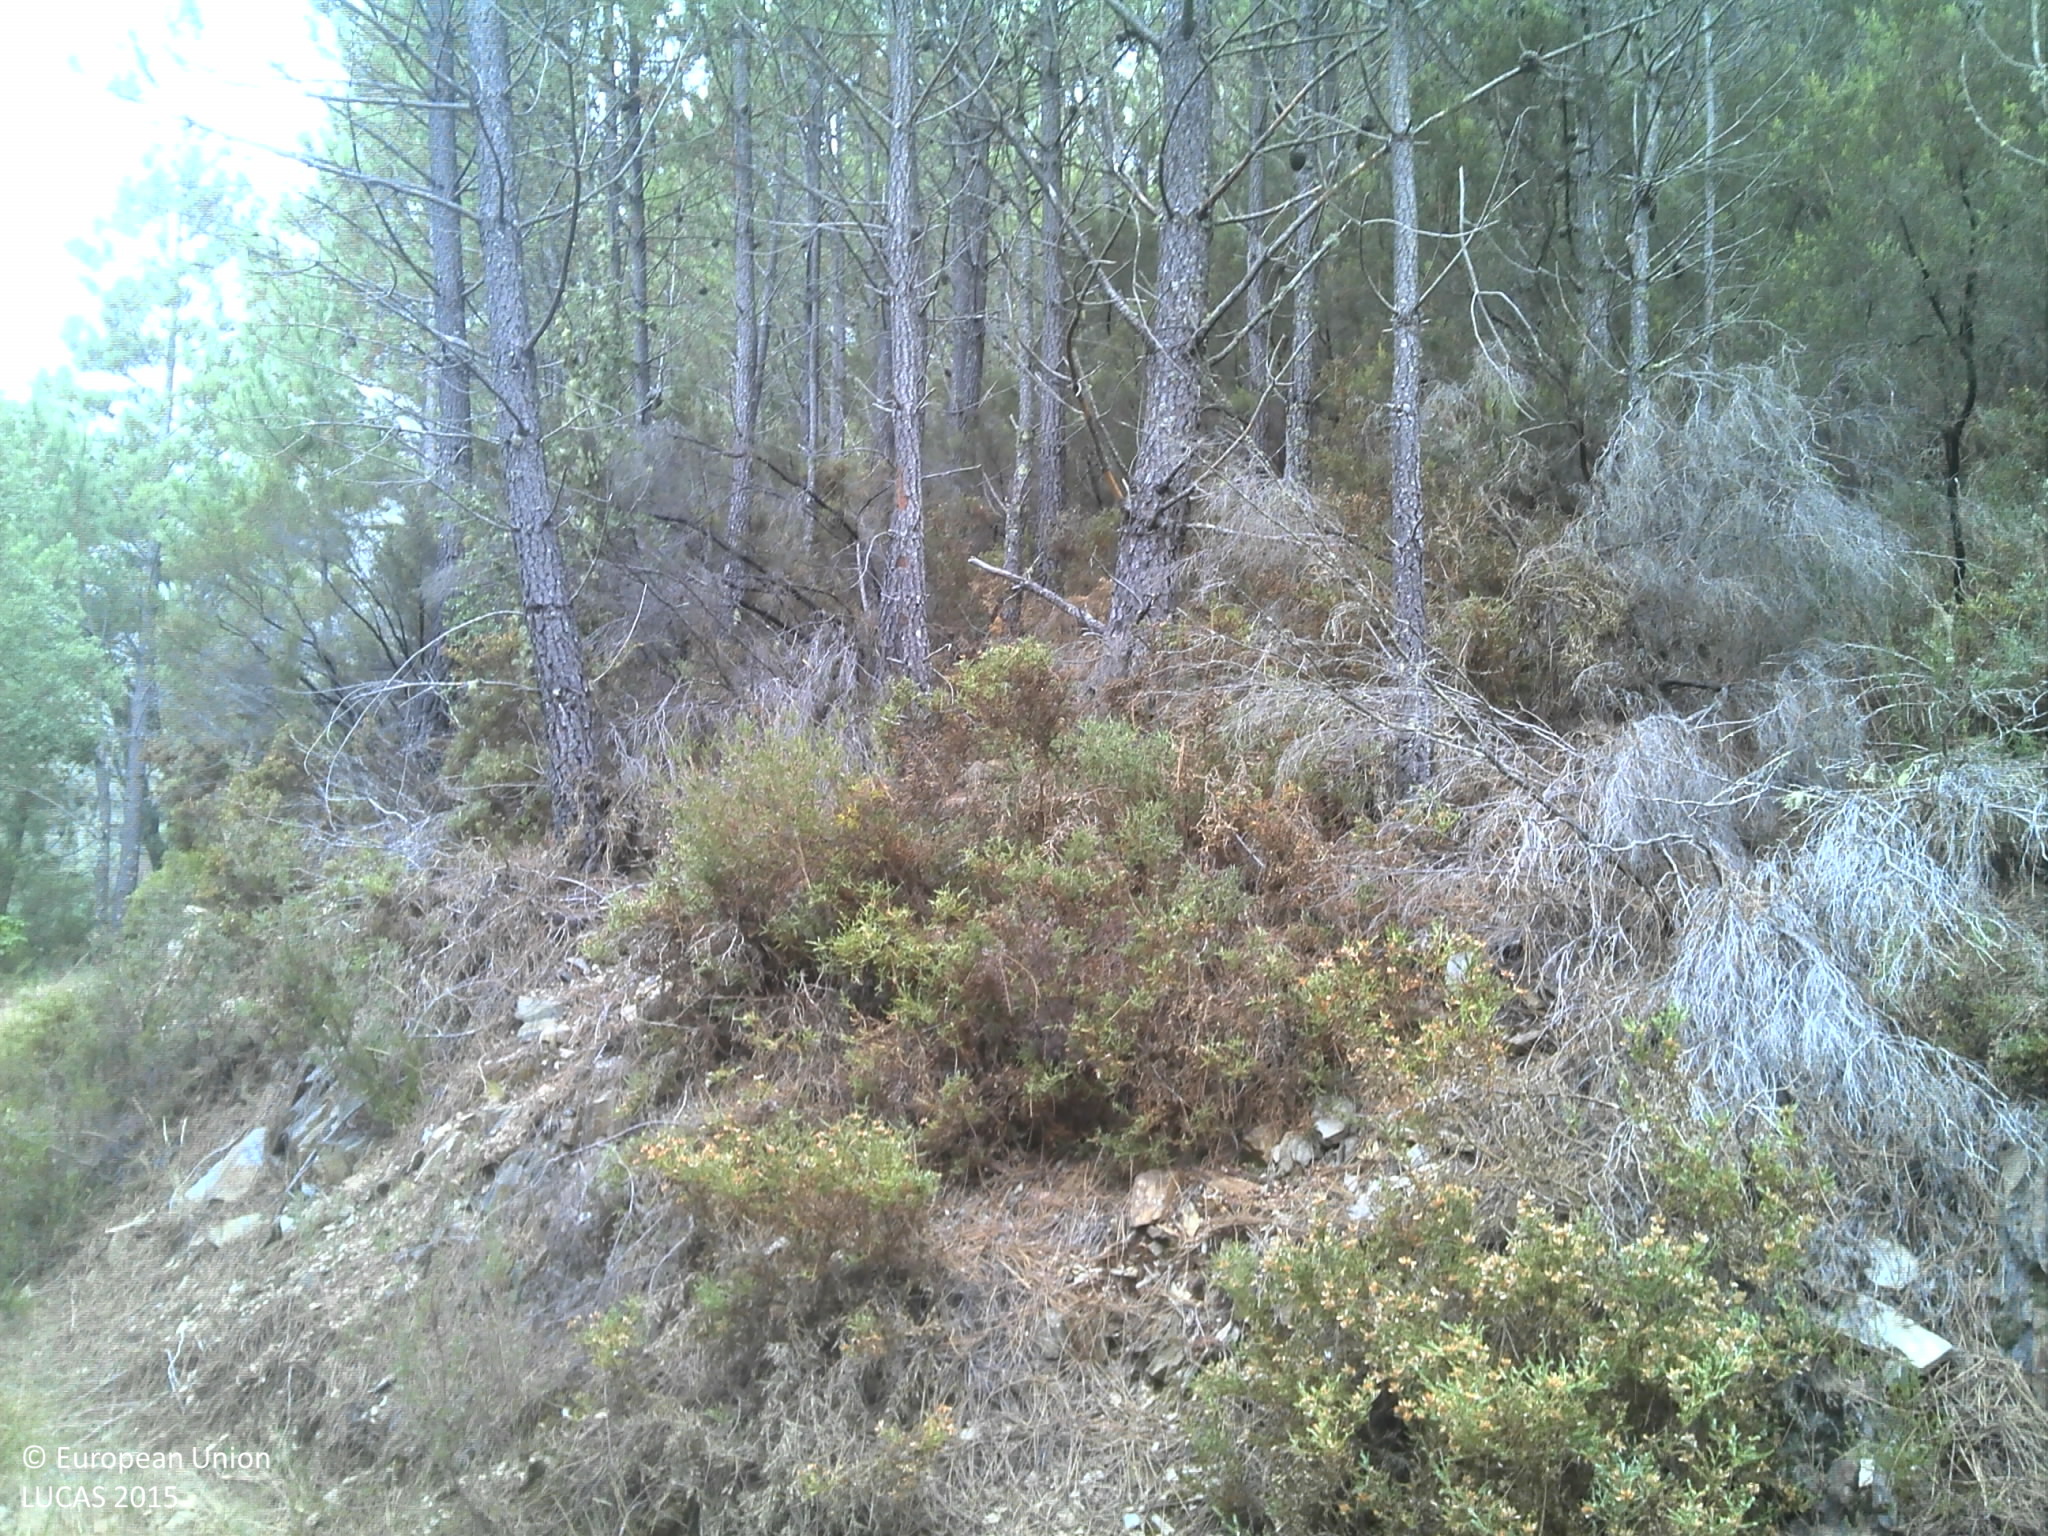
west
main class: Woodland
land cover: Pine dominated coniferous woodland
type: coniferous forest of the mediterranean region
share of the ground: 50 - 75 %
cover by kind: coniferous forest trees 70 %, shrubs 25 %, unconsolidated bare surface 5 %
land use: Forestry
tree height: > 5 m
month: July
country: PT
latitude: 40.2361
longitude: -7.8761
